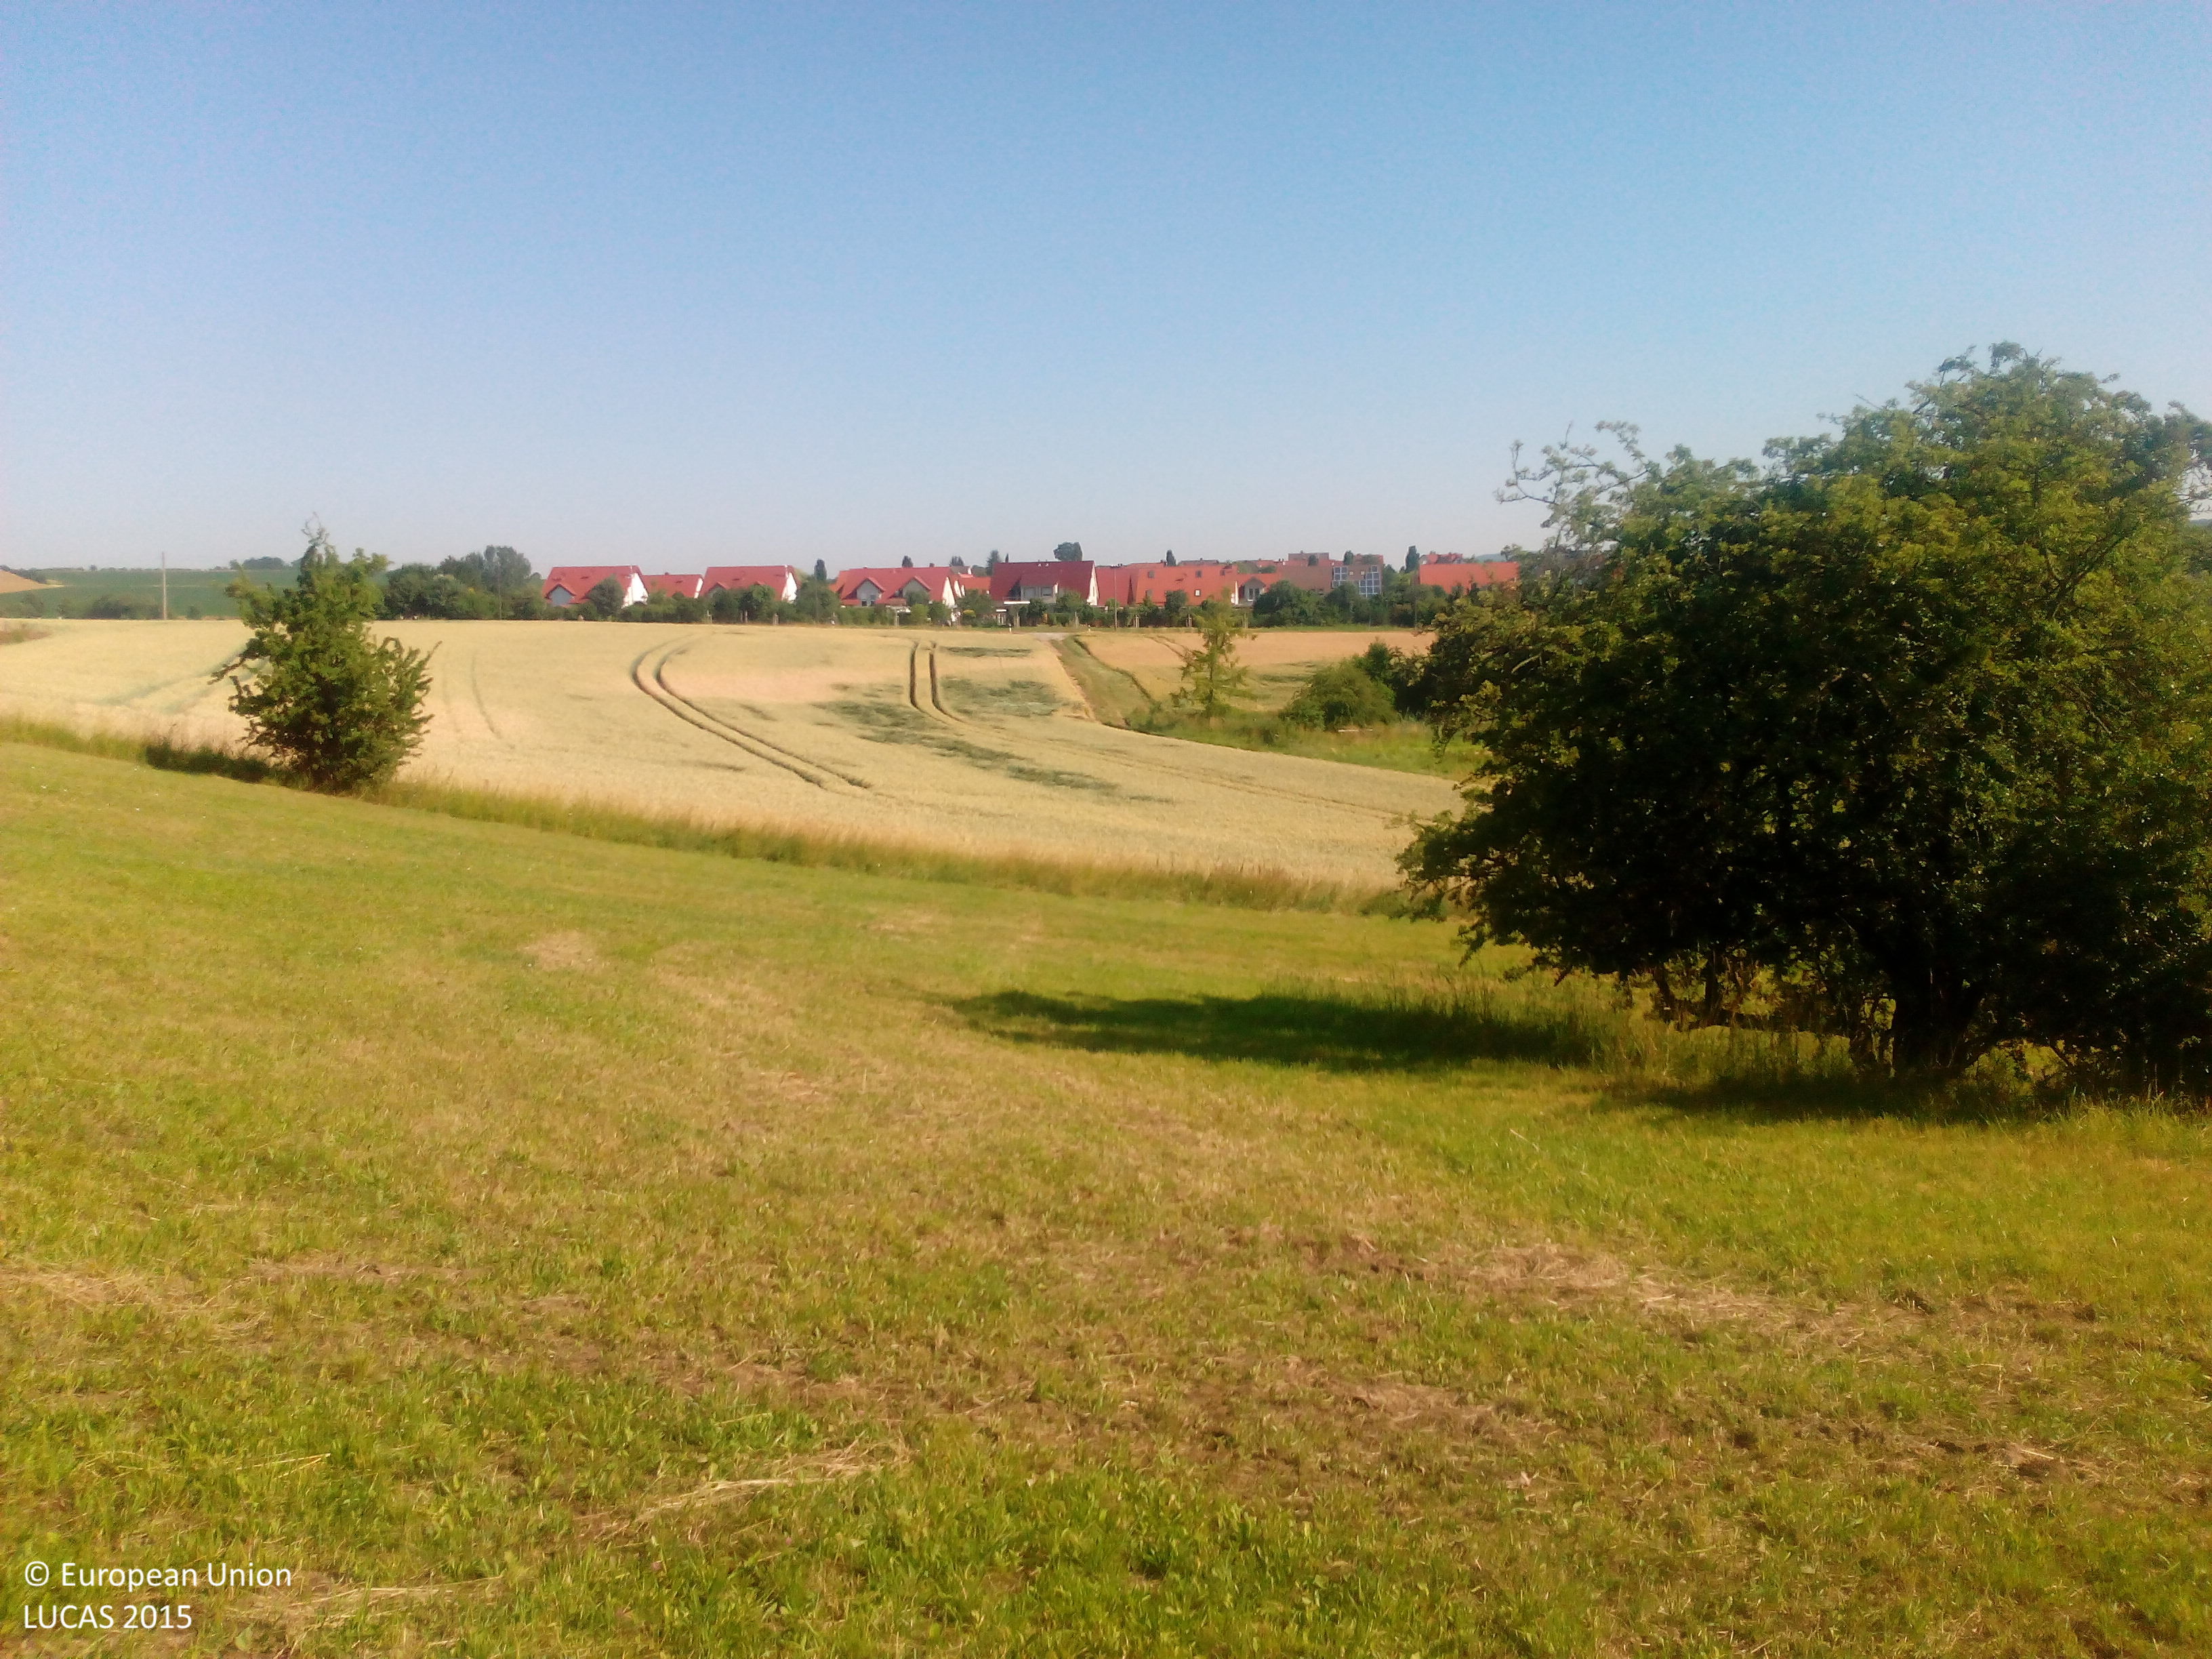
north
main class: Artificial land
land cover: Other artificial areas
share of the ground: > 75 %
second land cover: Grassland with sparse tree/shrub cover
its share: > 75 %
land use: Electricity, gas and thermal power distribution
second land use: Agriculture (excluding fallow land and kitchen gardens)
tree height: > 5 m
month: July
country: DE
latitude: 51.6944
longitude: 9.9566
